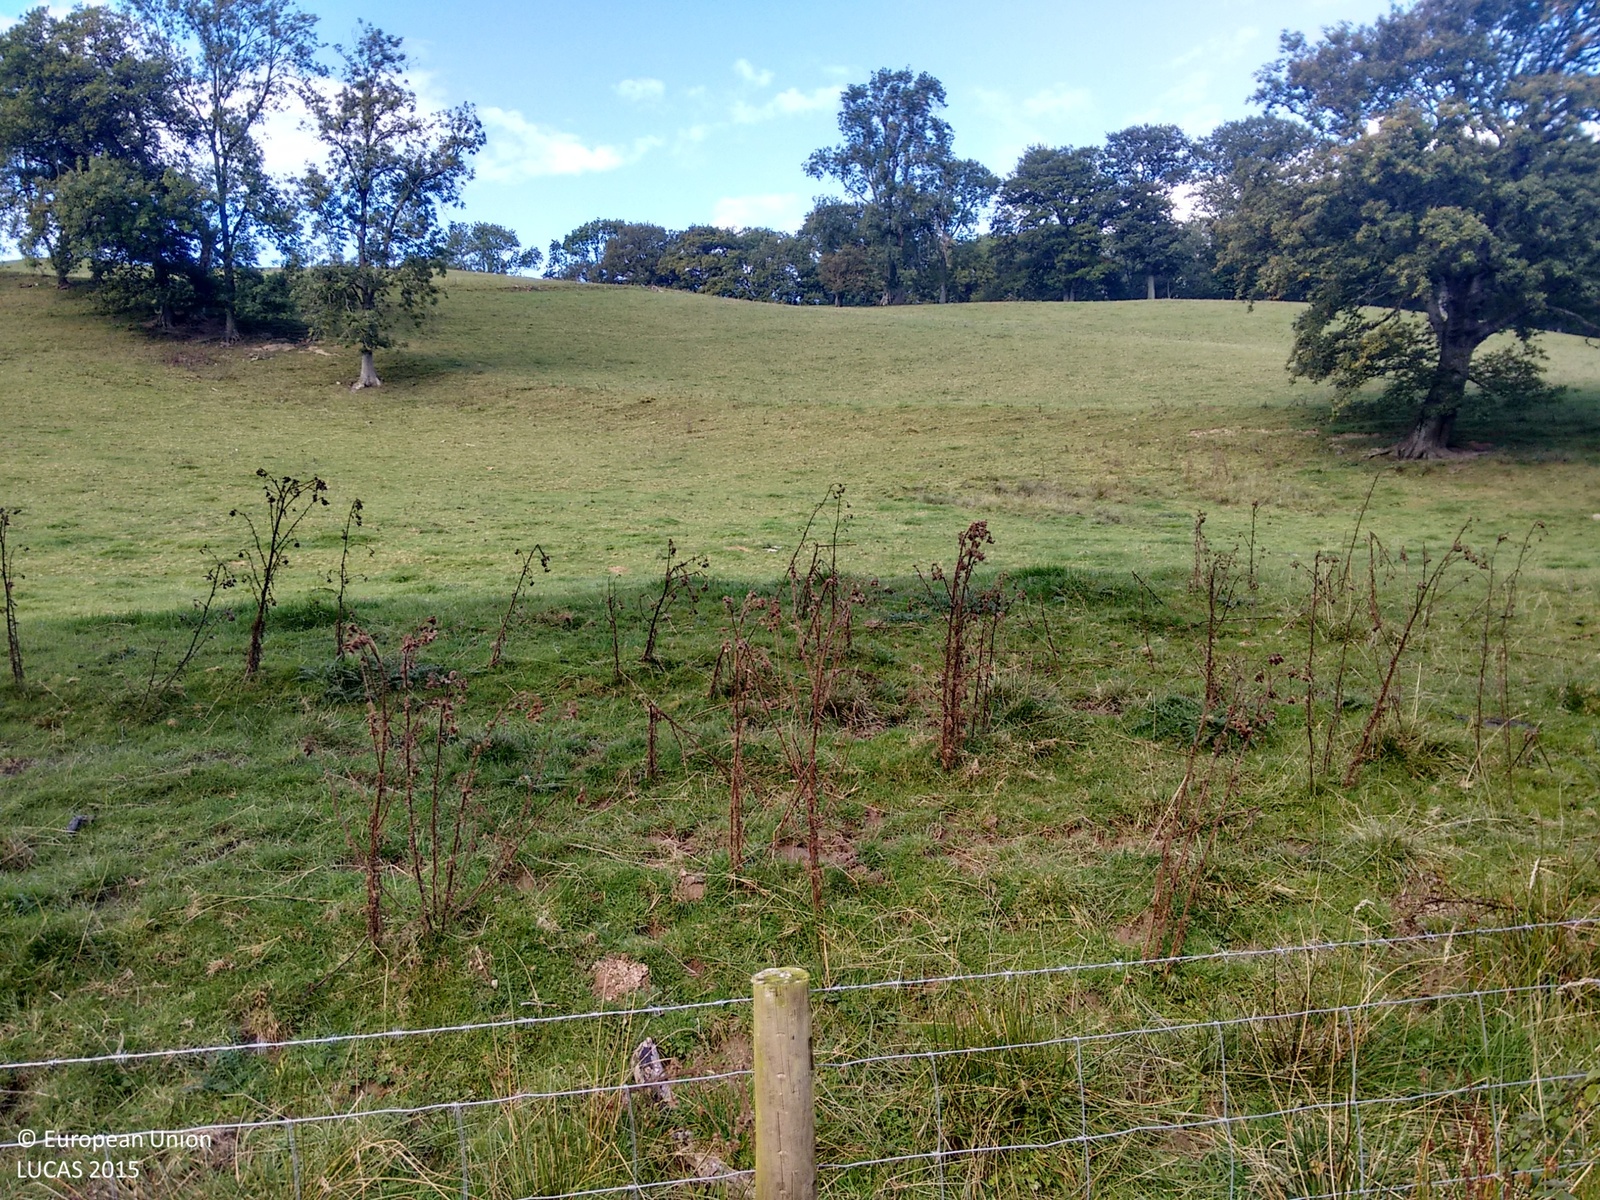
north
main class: Grassland
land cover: Grassland without tree/shrub cover
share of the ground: > 75 %
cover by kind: herbaceous plants 100 %
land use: Agriculture (excluding fallow land and kitchen gardens)
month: September
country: GB
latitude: 52.5952
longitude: -3.2629
